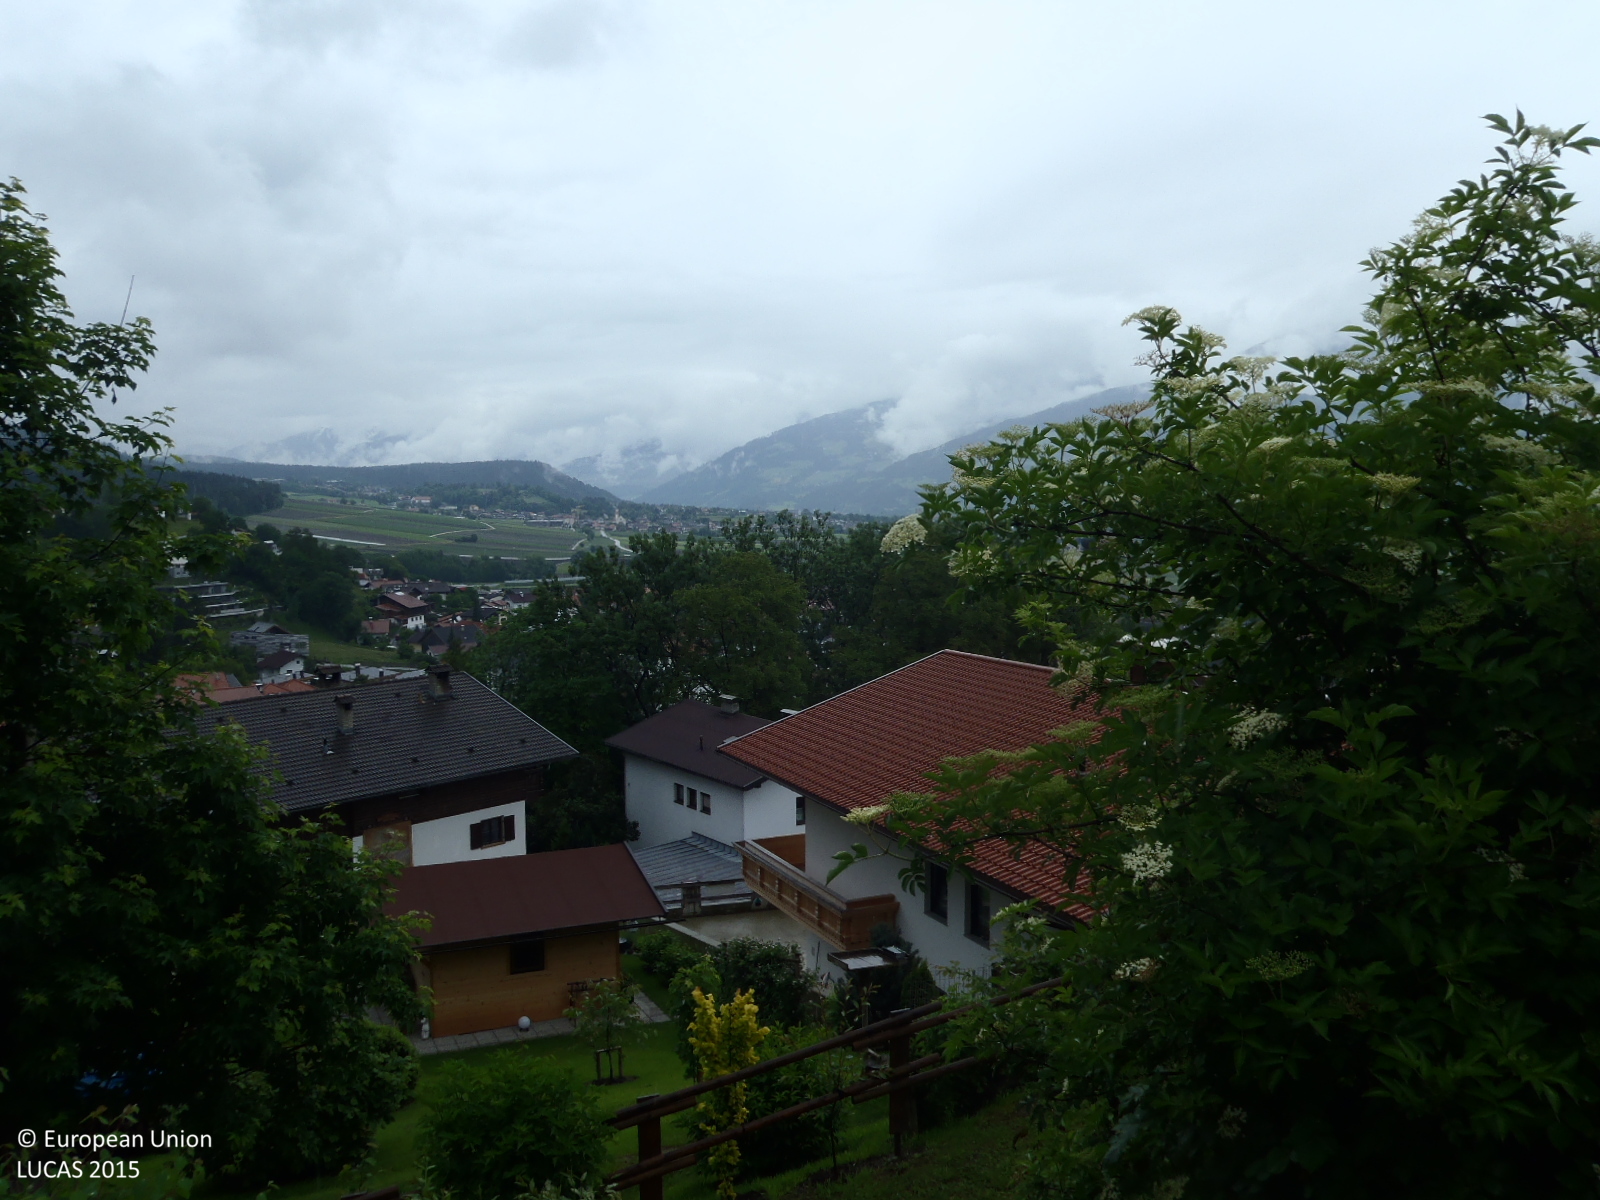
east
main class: Shrubland
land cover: Shrubland with sparse tree cover
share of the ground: > 75 %
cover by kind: shrubs 85 %, herbaceous plants 10 %, broadleaved forest trees 5 %
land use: Forestry
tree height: < 5 m
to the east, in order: Shrubland with sparse tree cover; Grass margins; Artificial constructions in urban areas; Broadleaved woodland; Grassland without tree/shrub cover; Artificial constructions in urban areas
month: May
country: AT
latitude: 47.2957
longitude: 11.4666
